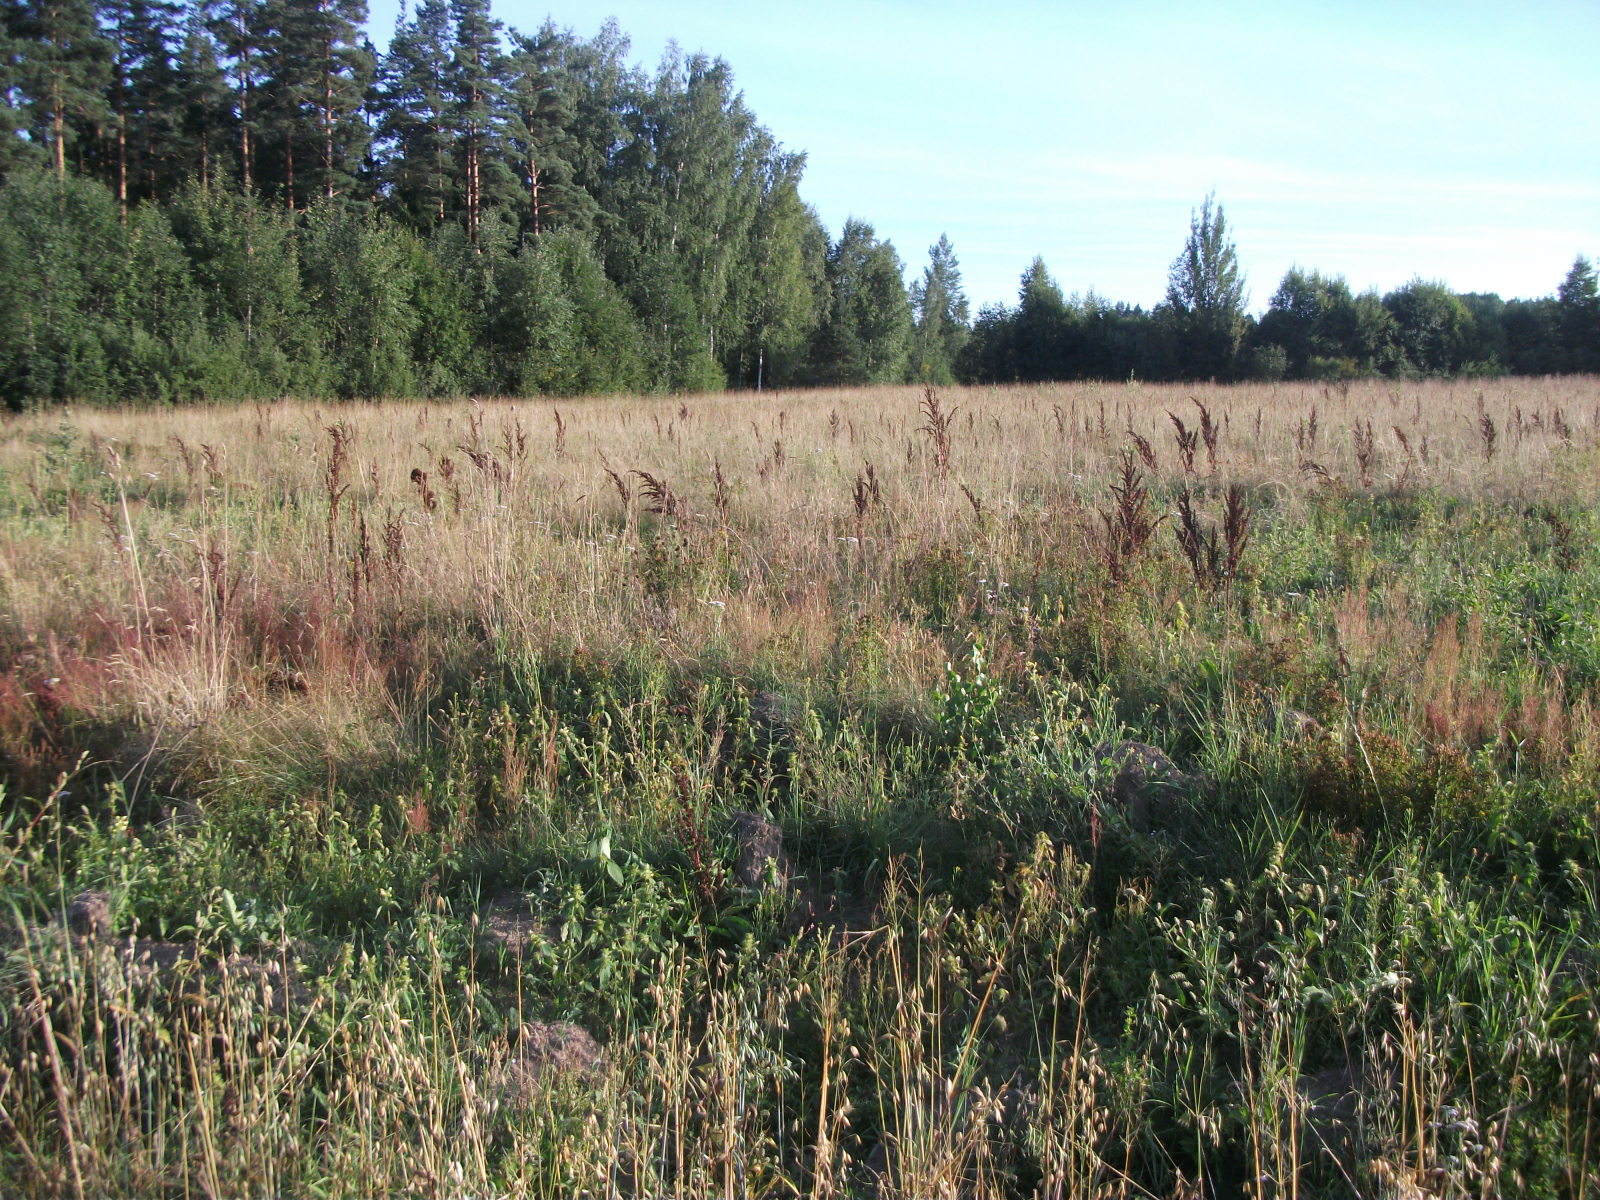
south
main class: Cropland
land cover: Oats
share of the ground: > 75 %
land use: Agriculture (excluding fallow land and kitchen gardens)
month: August
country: LV
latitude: 56.3989
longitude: 26.1959
